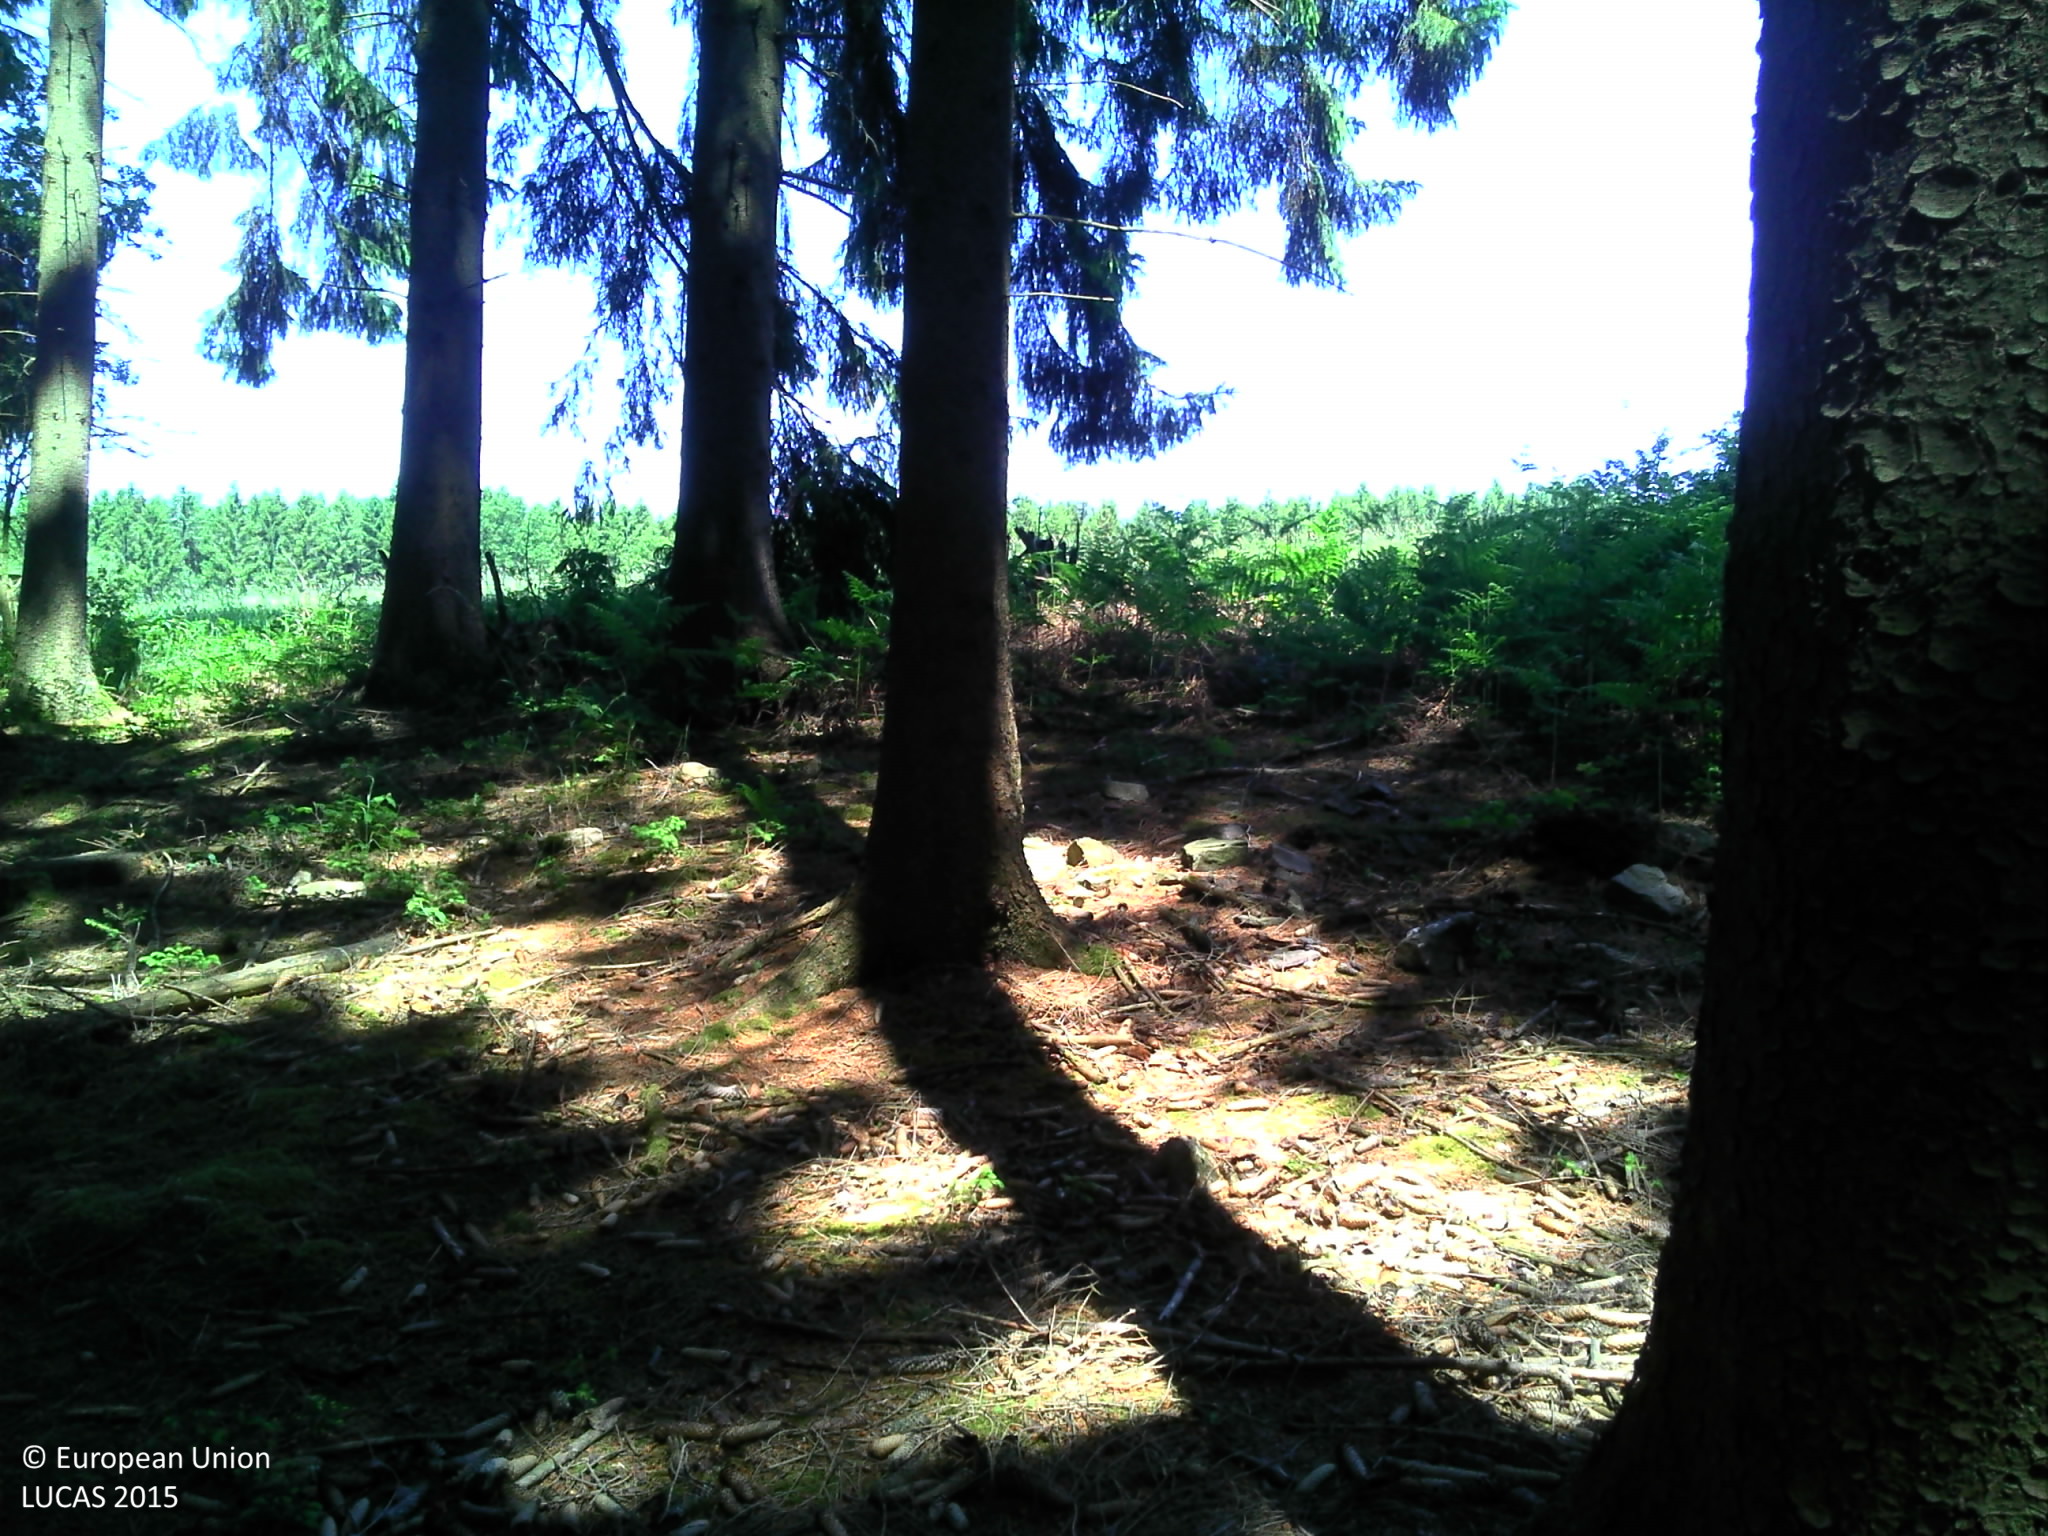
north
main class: Woodland
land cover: Spruce dominated coniferous woodland
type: exotic forest
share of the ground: > 75 %
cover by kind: coniferous forest trees 95 %, lichens and mosses 5 %
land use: Forestry
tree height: > 5 m
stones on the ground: < 10 %
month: June
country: BE
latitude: 50.5193
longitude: 5.7533
